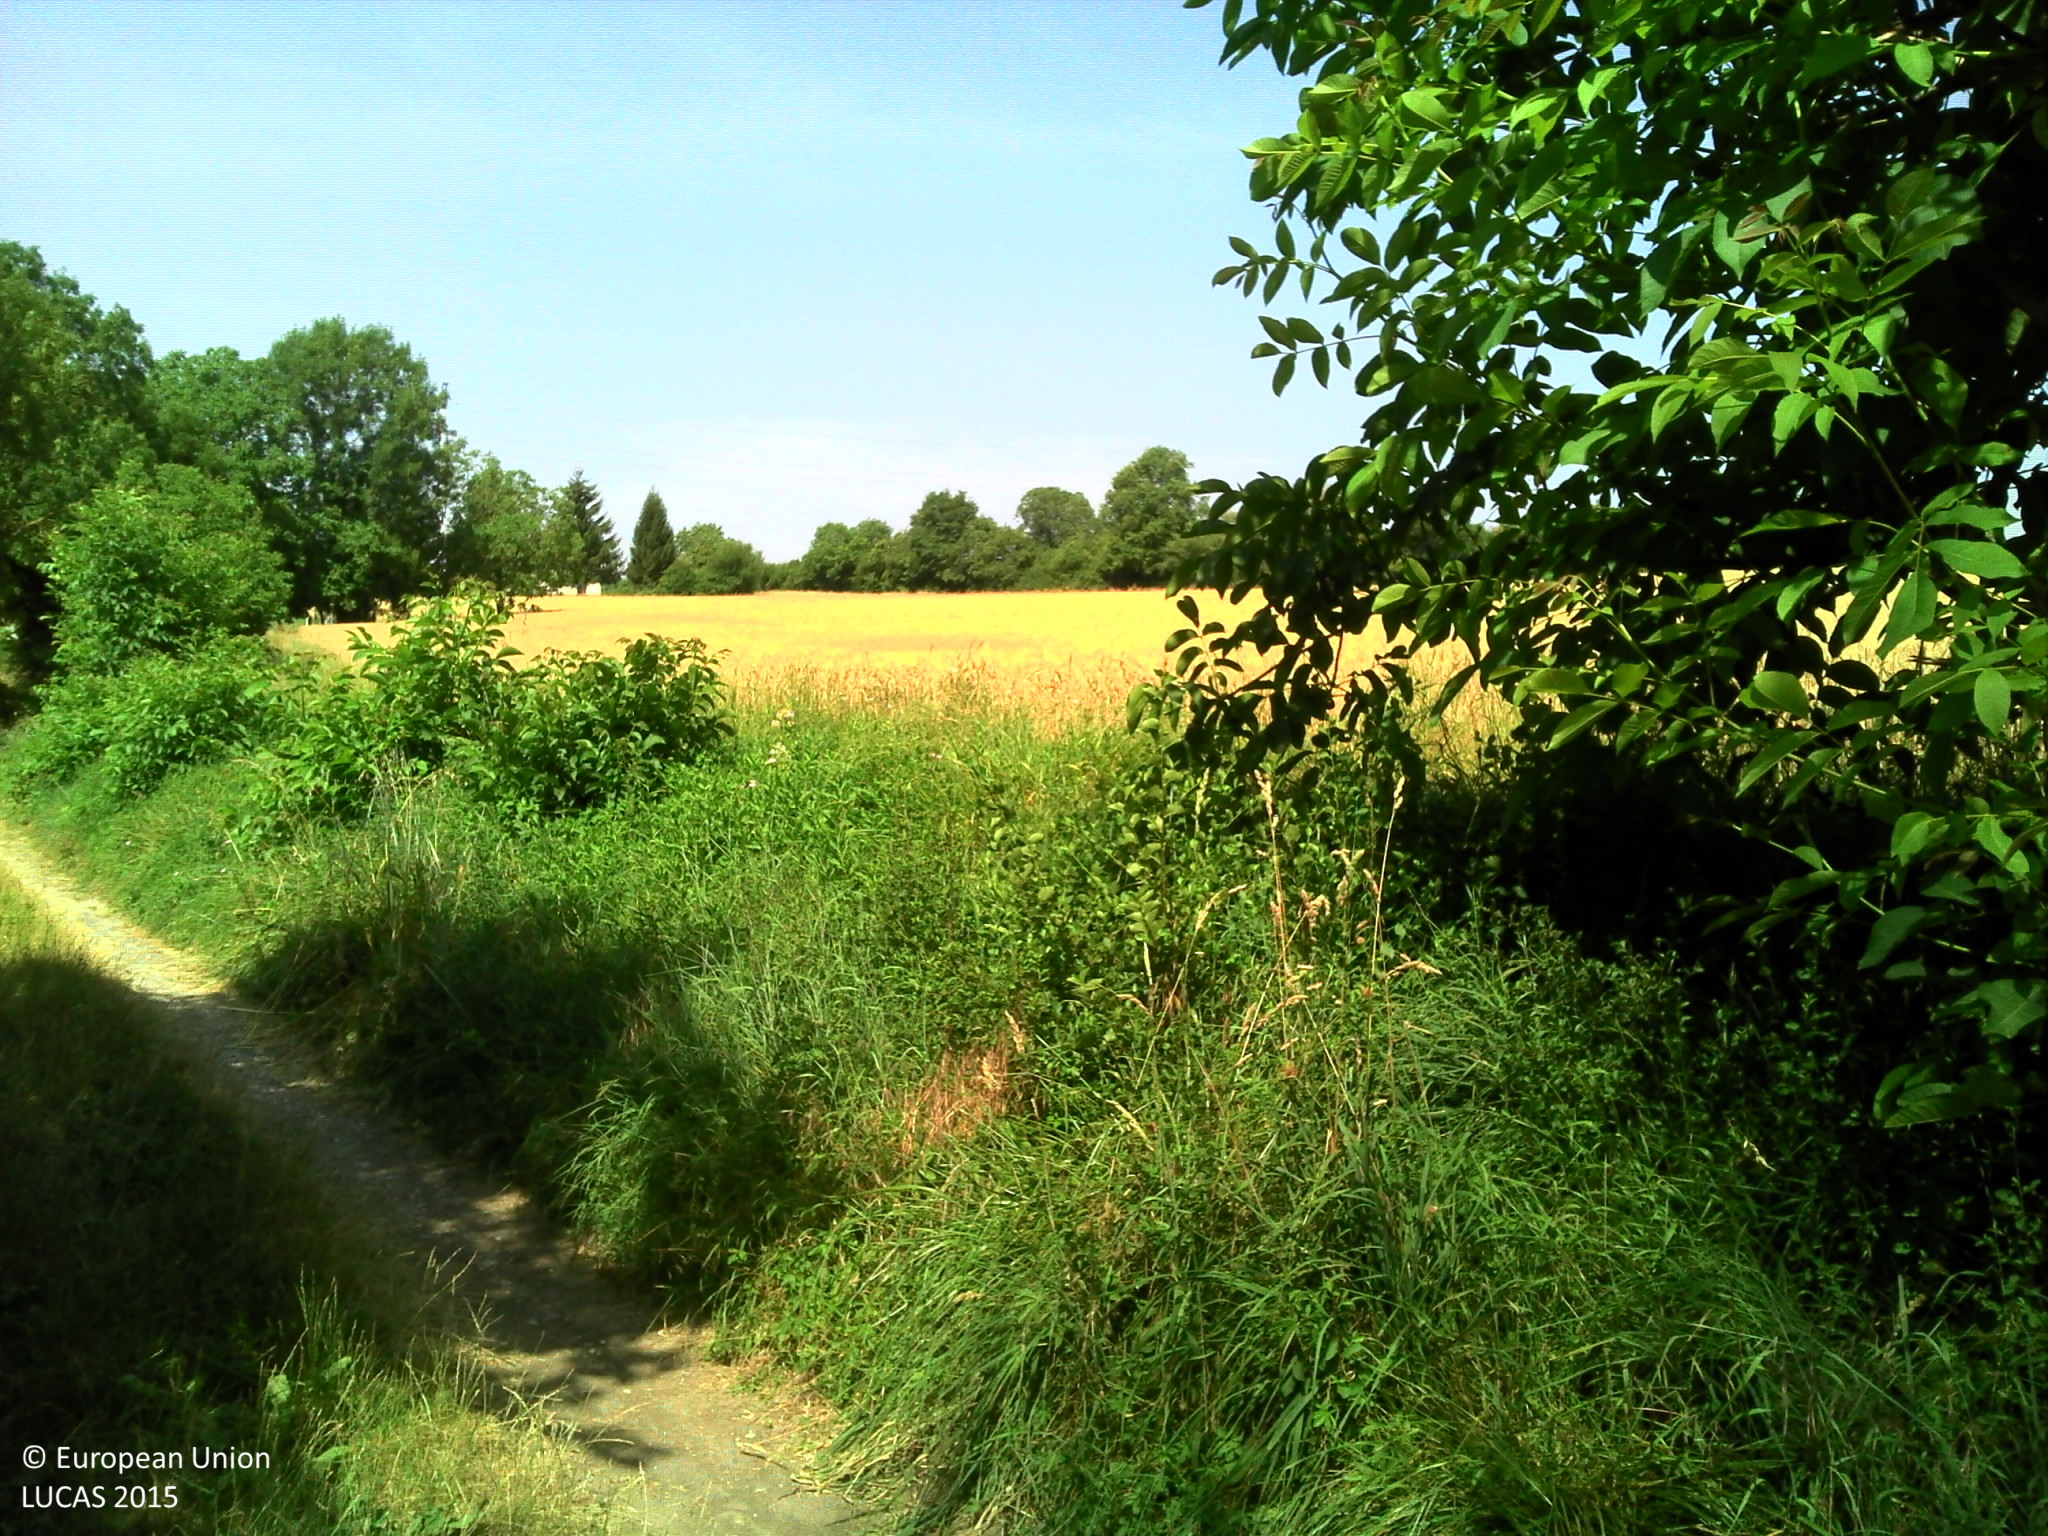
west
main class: Cropland
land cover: Durum wheat
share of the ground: > 75 %
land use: Agriculture (excluding fallow land and kitchen gardens)
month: July
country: FR
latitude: 45.7837
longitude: 5.4121
